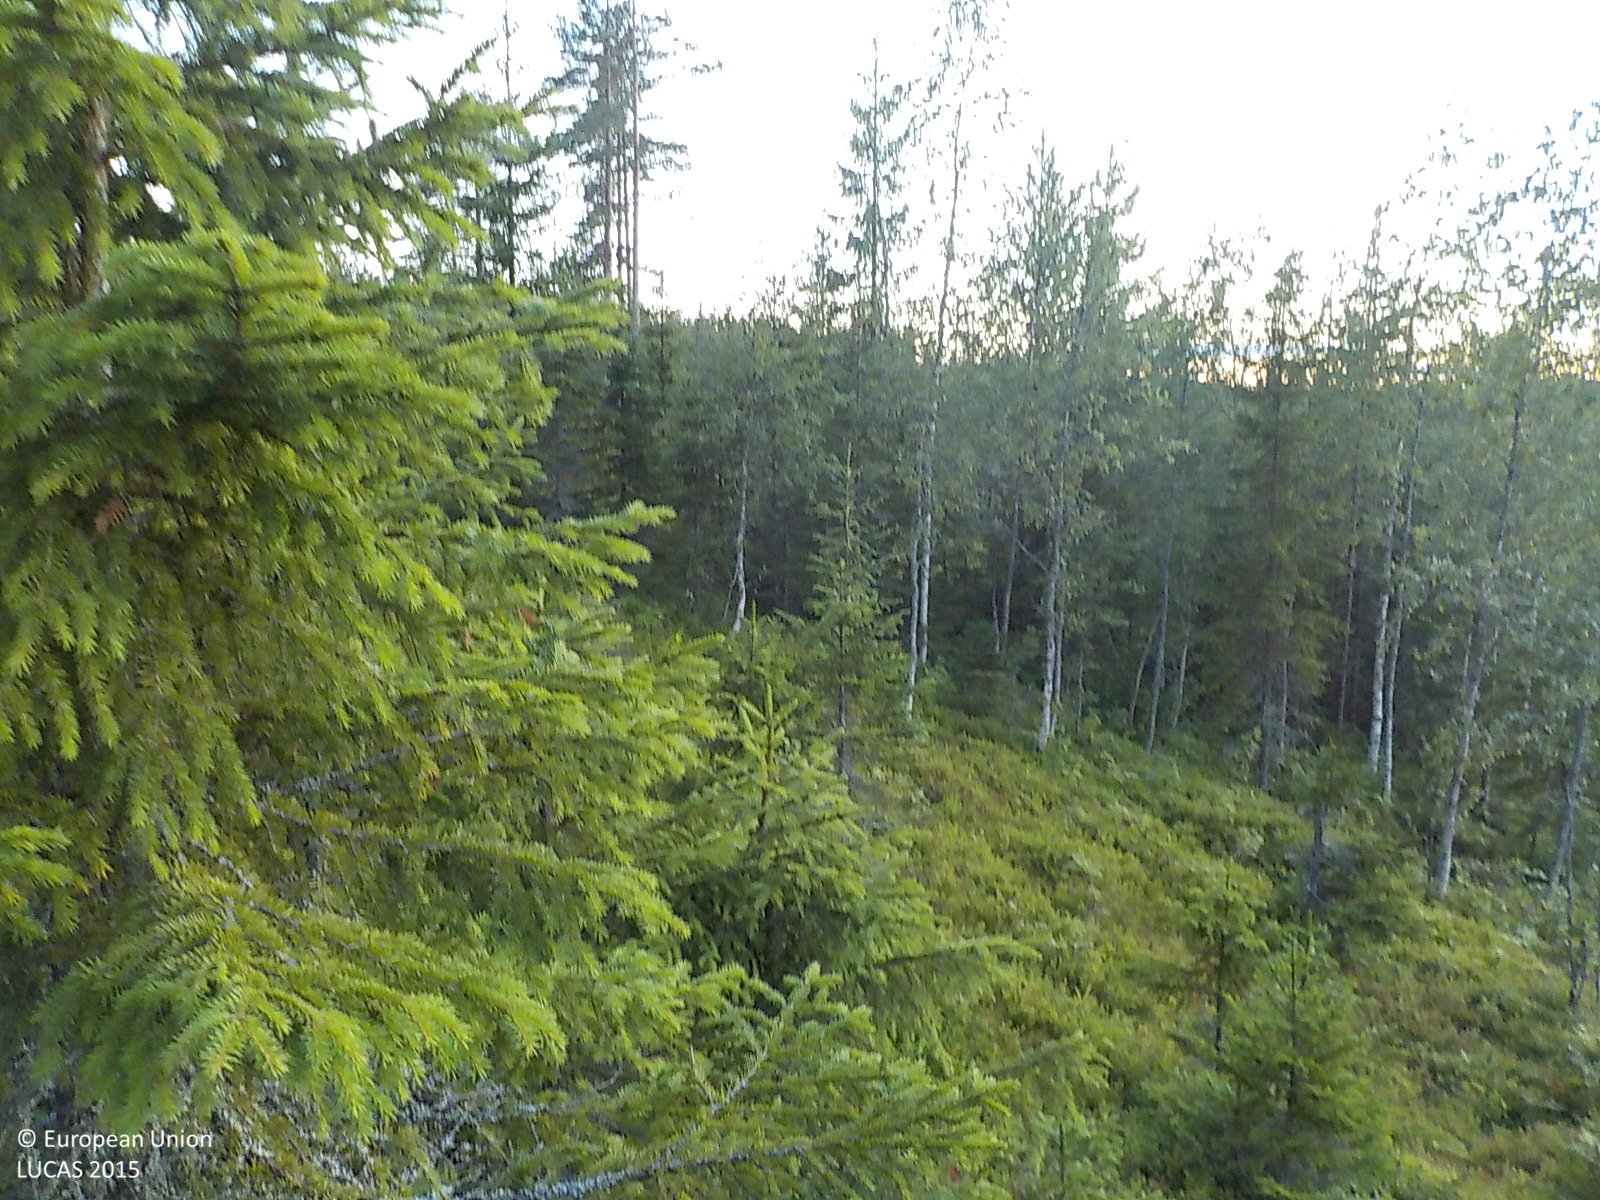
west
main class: Woodland
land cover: Pine dominated mixed woodland
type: boreal forest
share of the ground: 10 - 25 %
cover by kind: shrubs 80 %, coniferous forest trees 15 %, broadleaved forest trees 5 %
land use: Forestry
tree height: > 5 m
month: August
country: SE
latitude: 63.4792
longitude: 18.8296
